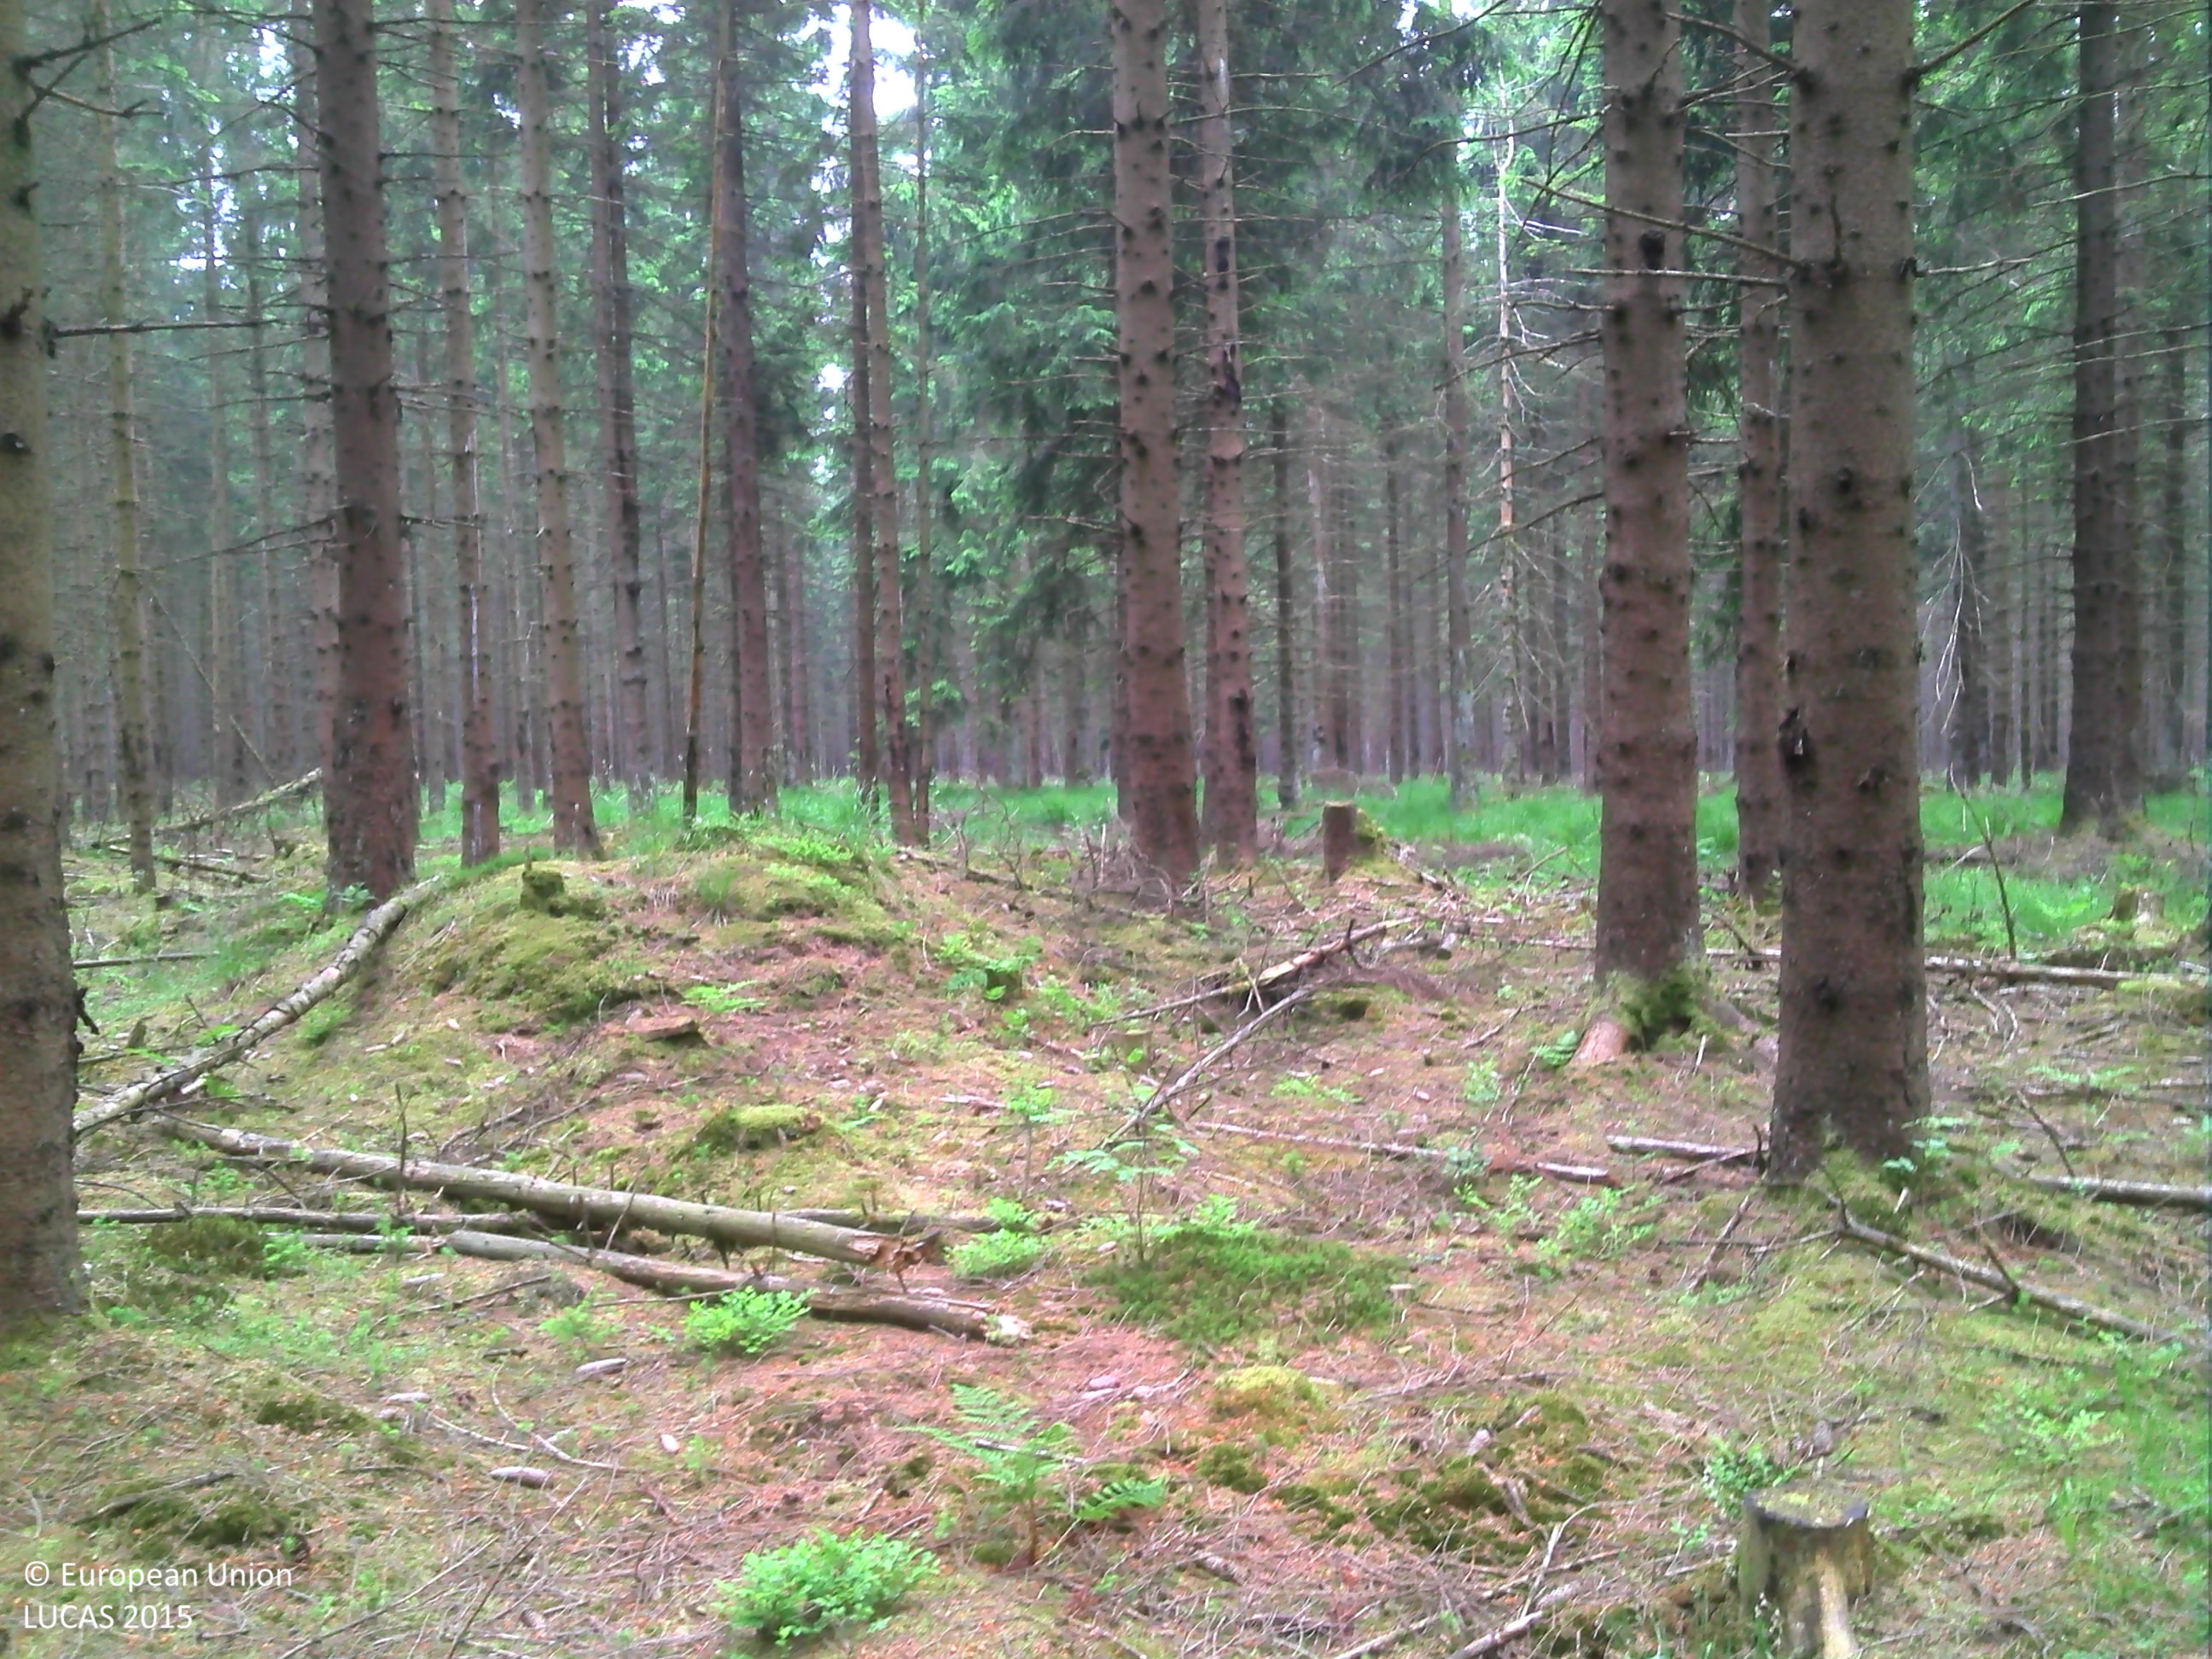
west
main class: Woodland
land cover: Spruce dominated coniferous woodland
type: exotic forest
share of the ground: > 75 %
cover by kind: coniferous forest trees 95 %, herbaceous plants 5 %
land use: Forestry
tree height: > 5 m
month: June
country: BE
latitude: 50.4661
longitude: 6.2942
